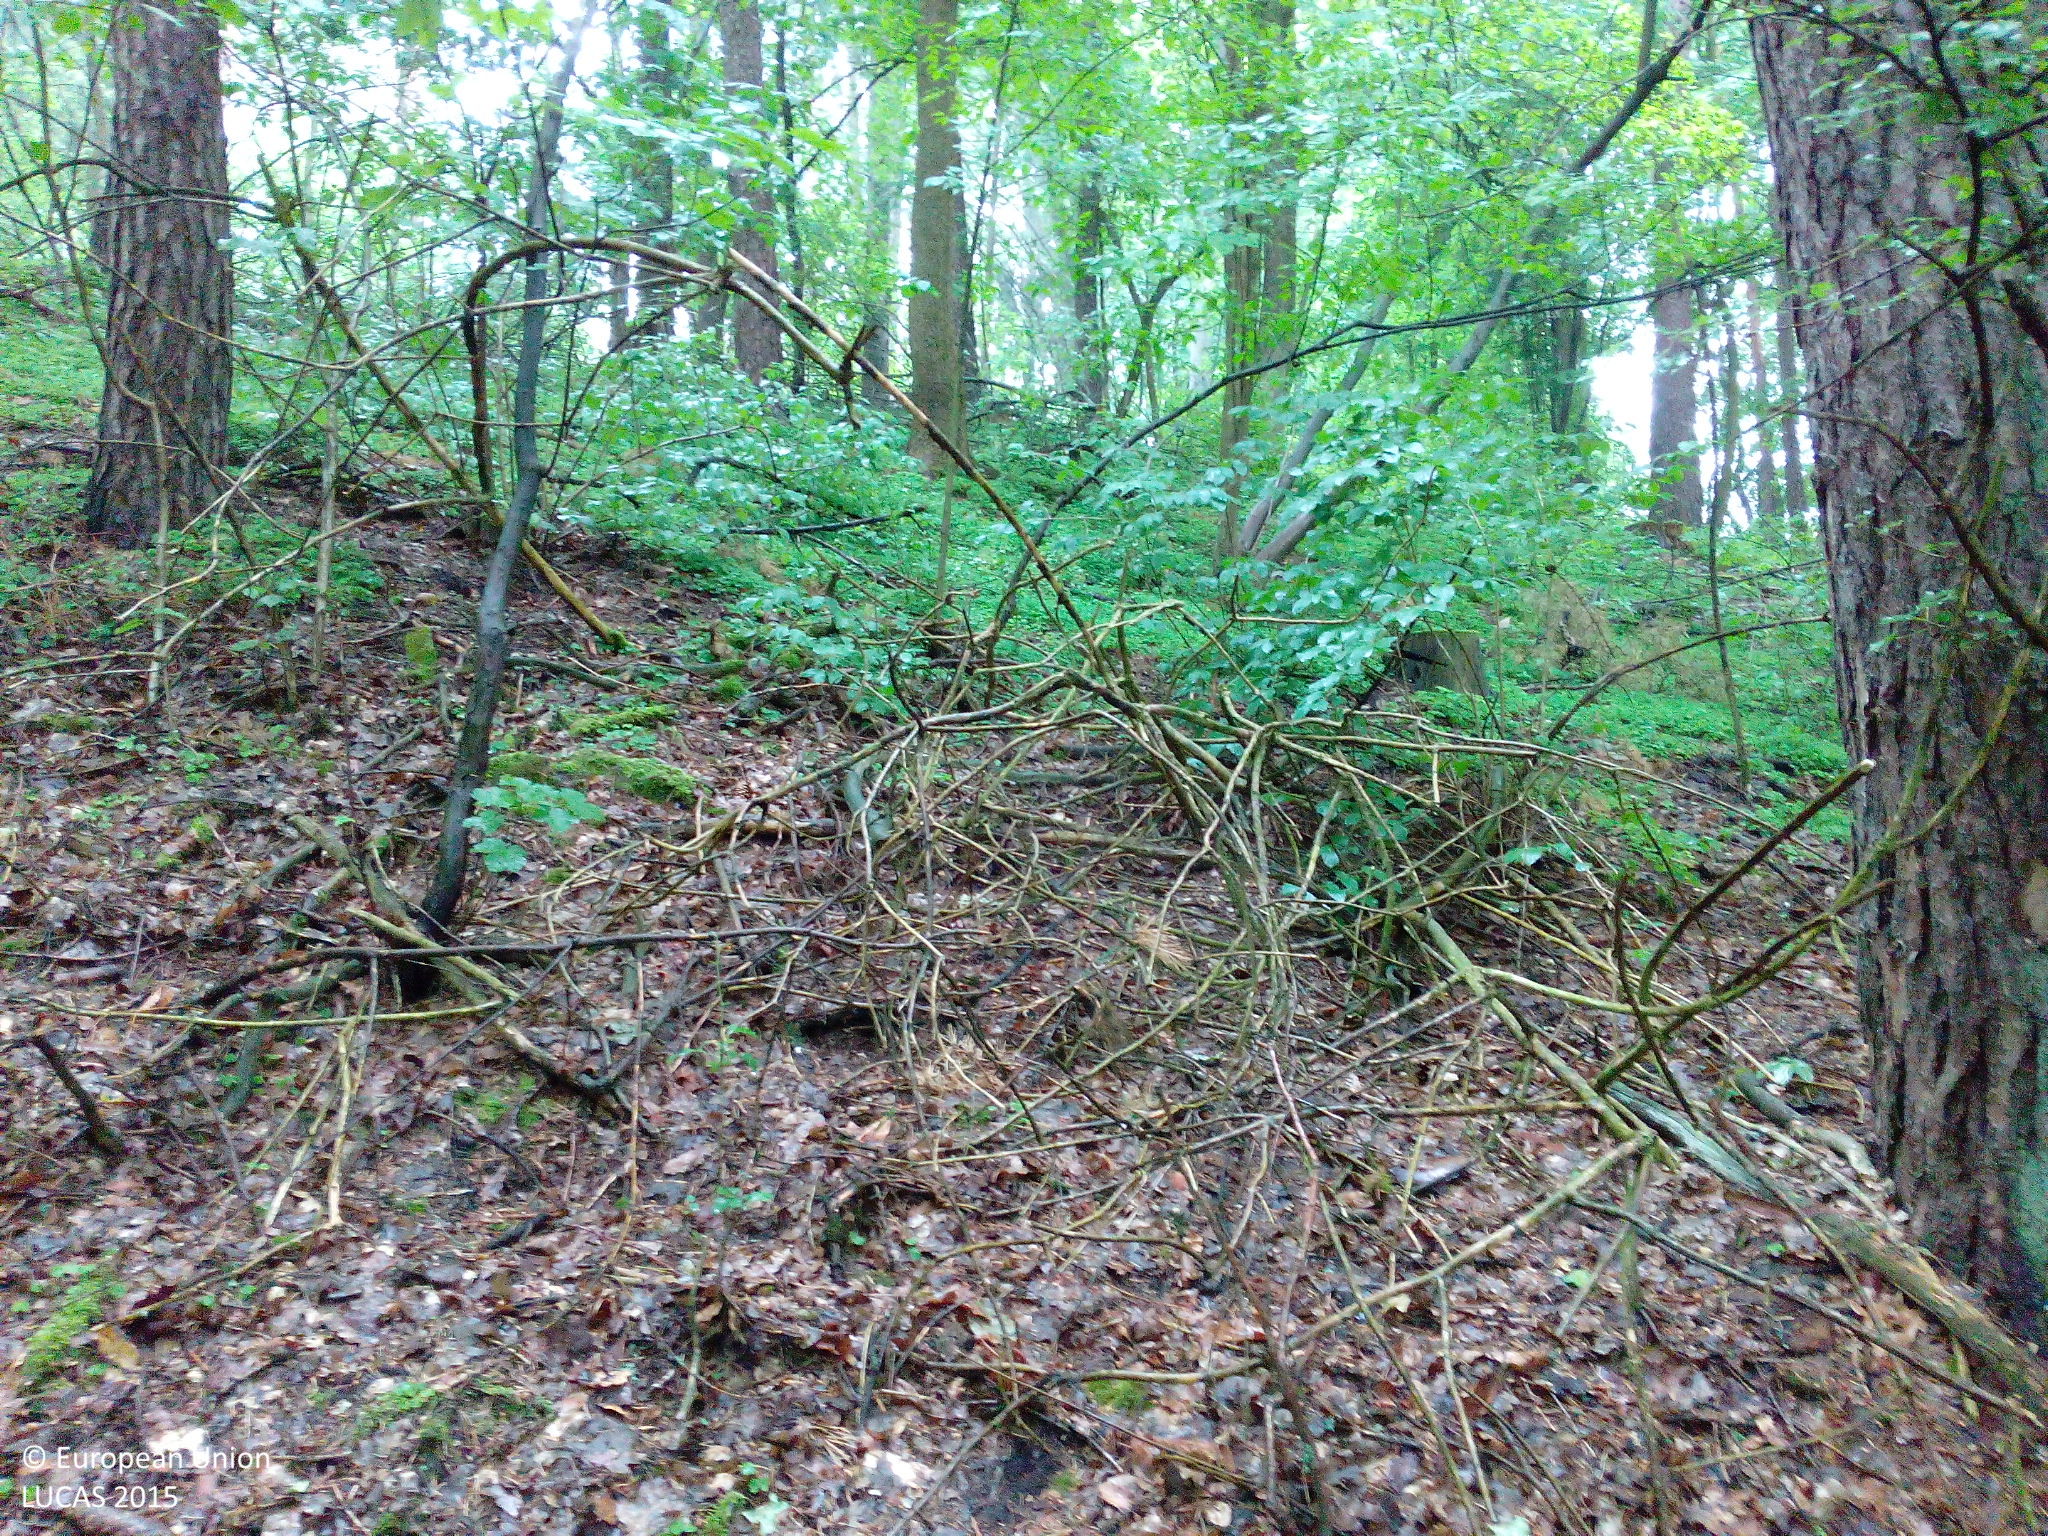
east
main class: Woodland
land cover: Pine dominated mixed woodland
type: hemiboreal forest and nemoral coniferous forest and mixed broadleaved-coniferous forest
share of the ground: > 75 %
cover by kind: coniferous forest trees 65 %, broadleaved forest trees 30 %, unconsolidated bare surface 5 %
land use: Forestry
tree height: > 5 m
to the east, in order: Pine dominated mixed woodland; Tracks; Pine dominated mixed woodland; Tracks; Pine dominated mixed woodland; Groves; Grass margins; Tracks; Grass margins; Triticale
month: June
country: DE
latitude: 50.1021
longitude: 11.5235
